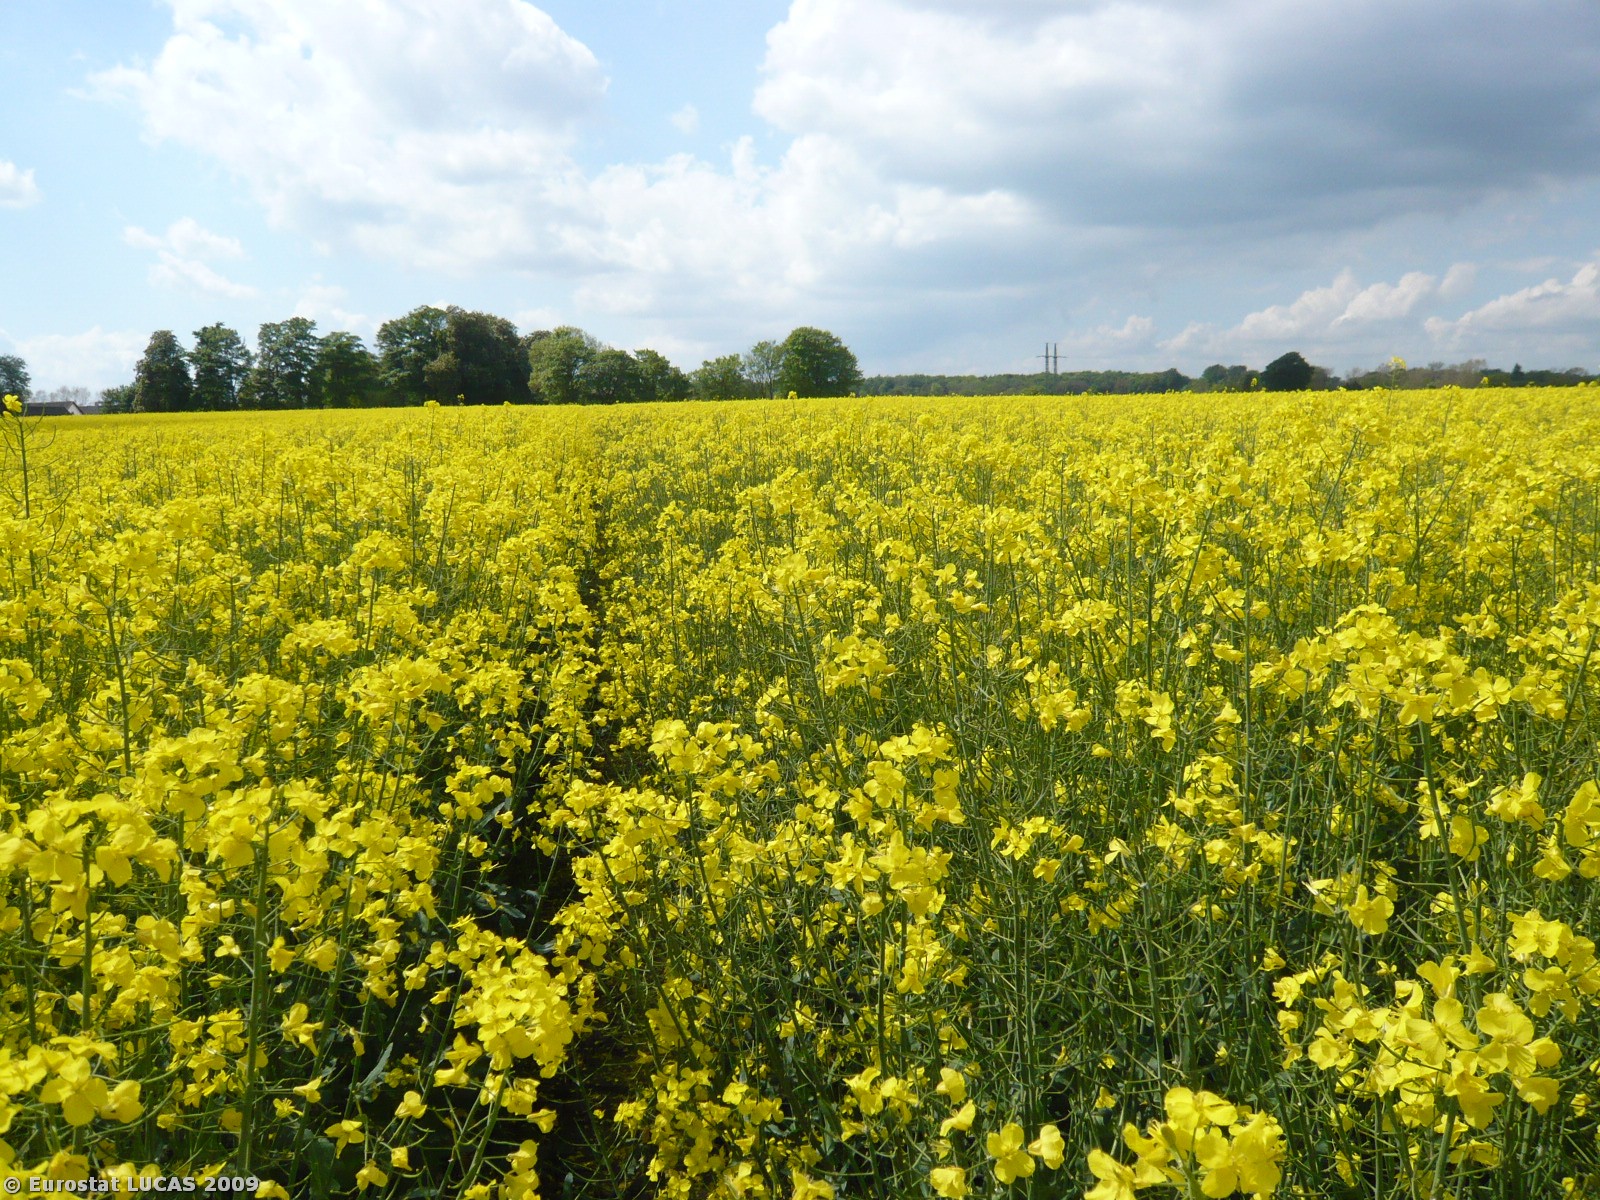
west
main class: Cropland
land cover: Rape and turnip rape
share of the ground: > 75 %
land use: Agriculture (excluding fallow land and kitchen gardens)
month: May
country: DK
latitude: 55.4154
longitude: 12.0993
